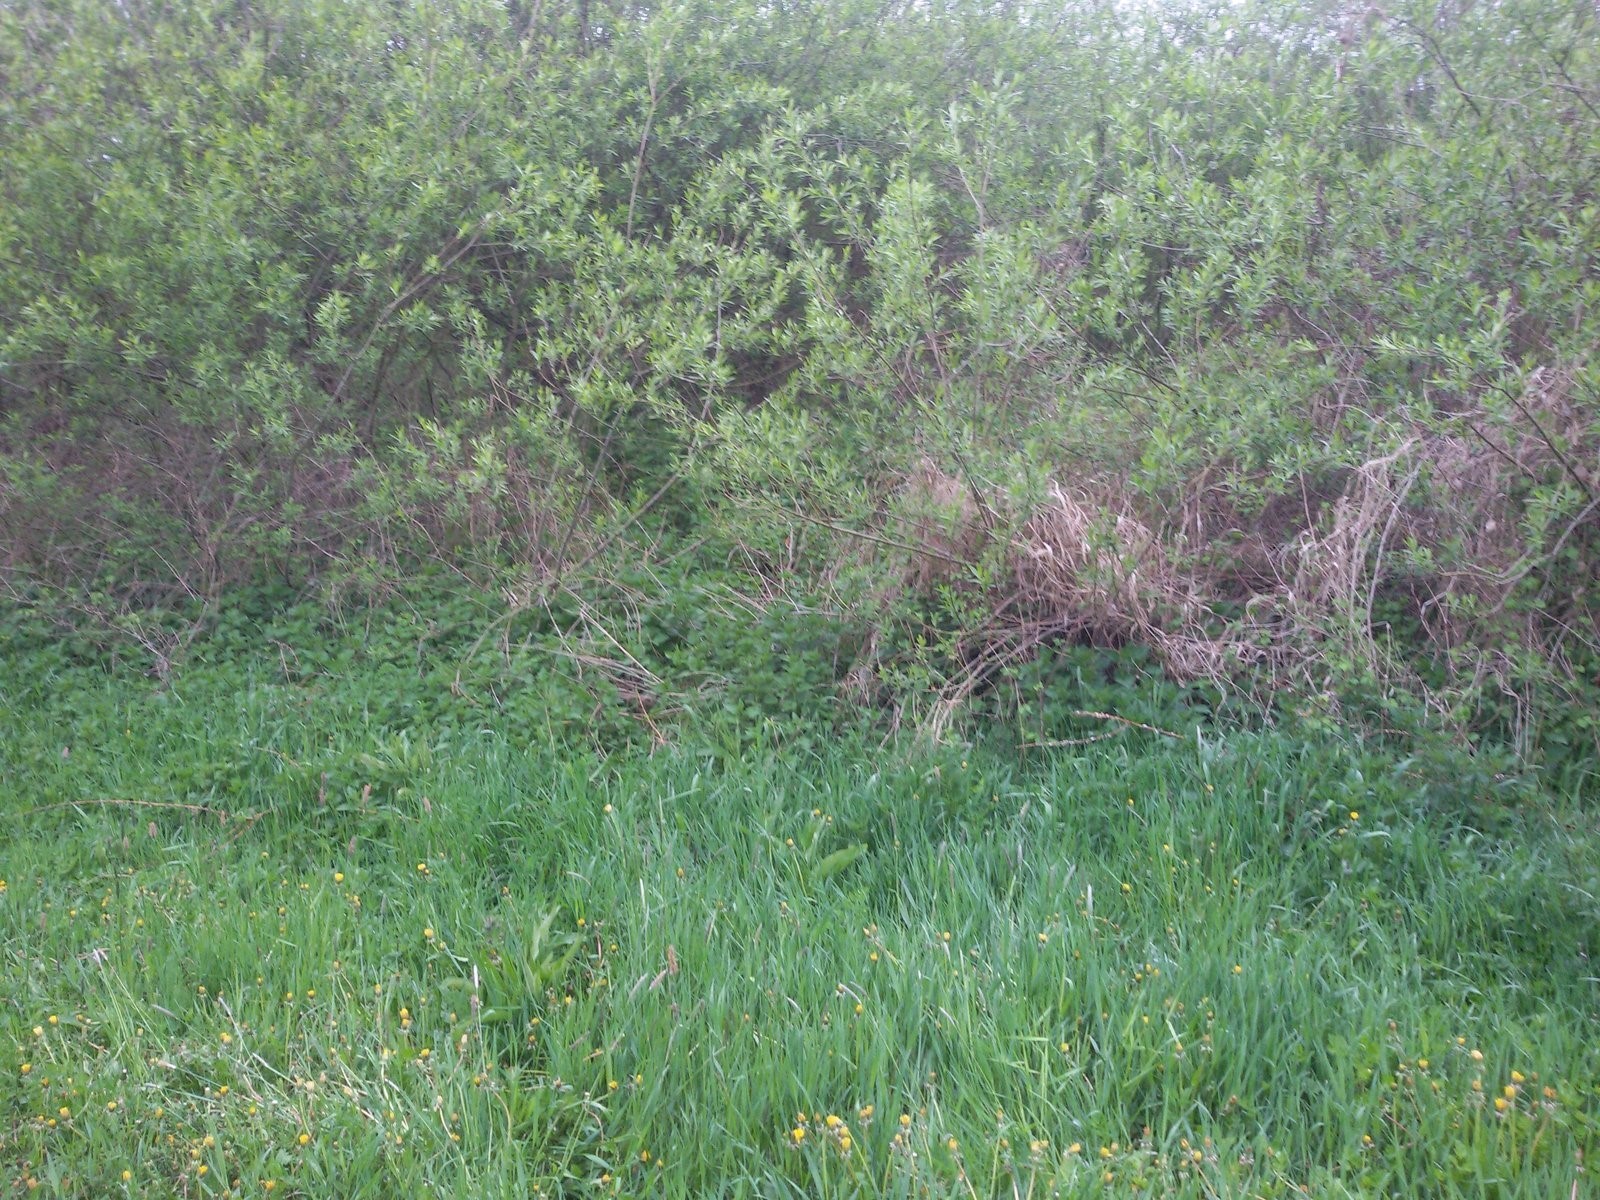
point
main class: Shrubland
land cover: Shrubland without tree cover
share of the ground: 25 - 50 %
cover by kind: herbaceous plants 70 %, shrubs 30 %
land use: Semi-natural and natural areas not in use
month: May
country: PL
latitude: 50.4296
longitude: 21.3813
